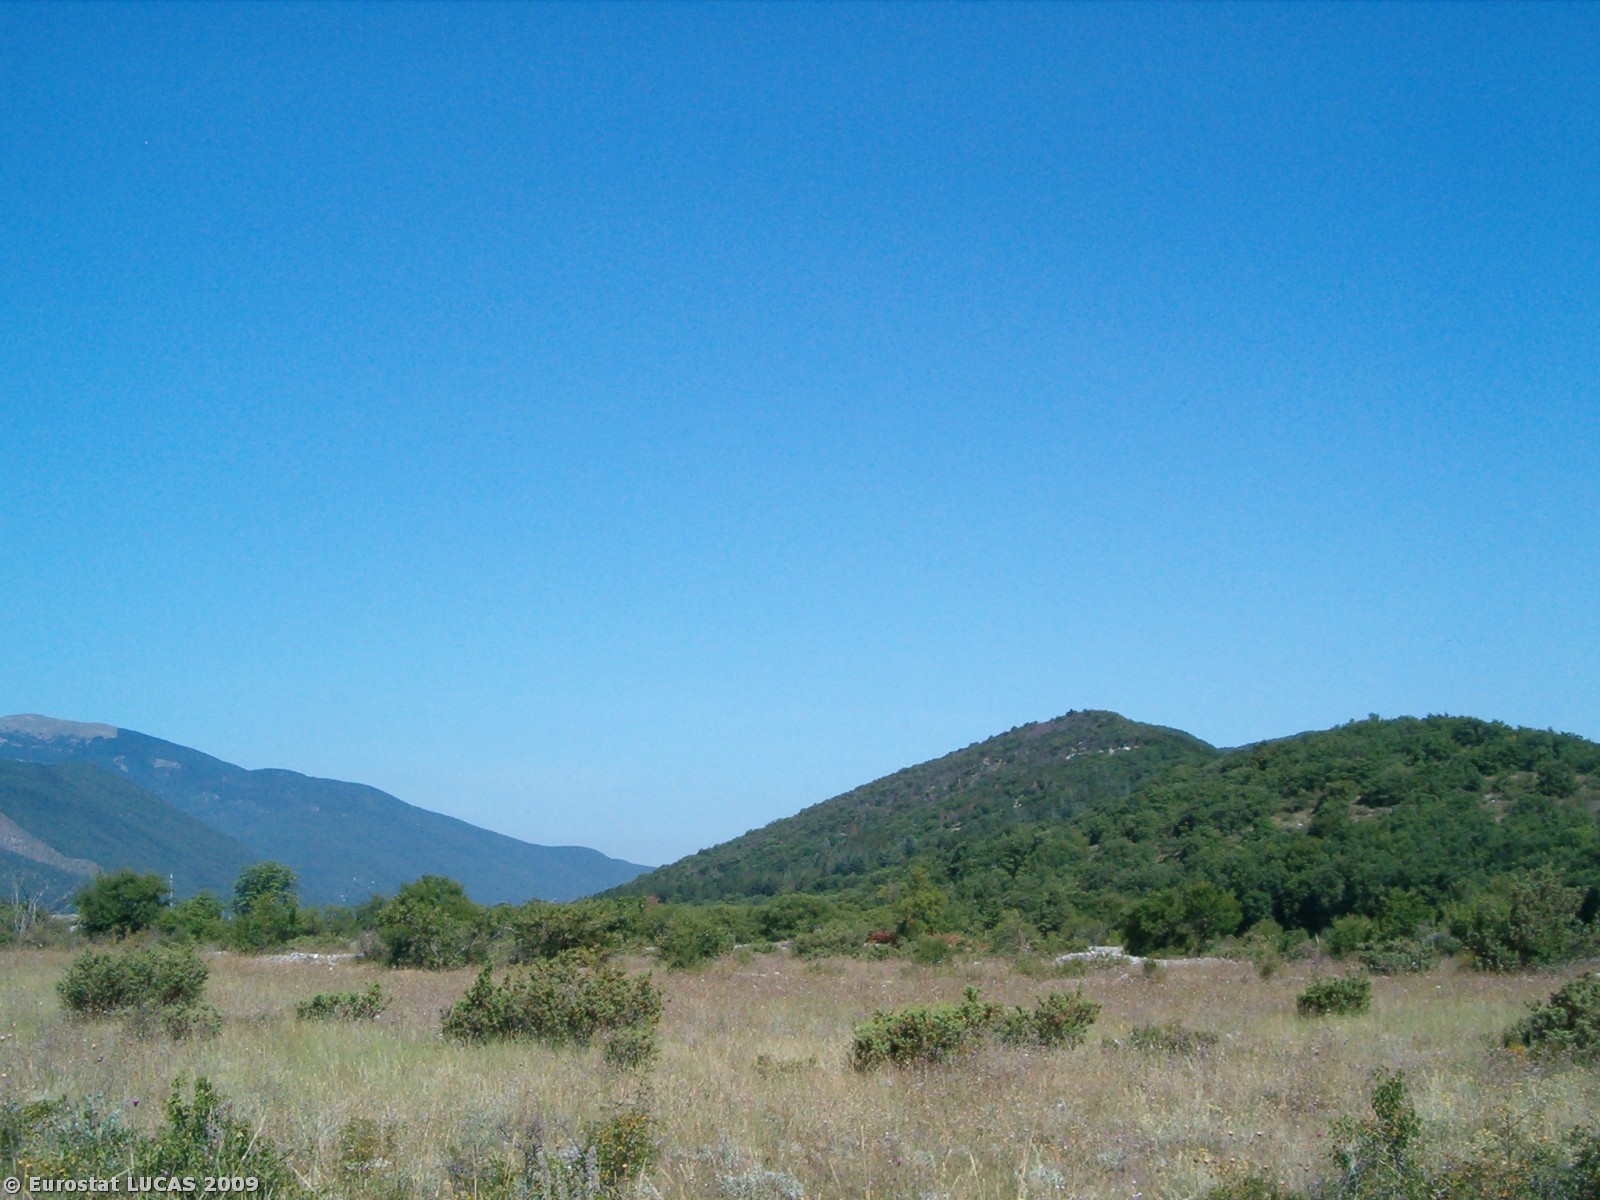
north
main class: Grassland
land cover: Grassland without tree/shrub cover
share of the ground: > 75 %
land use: Agriculture (excluding fallow land and kitchen gardens)
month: July
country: IT
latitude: 41.8843
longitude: 13.6146
